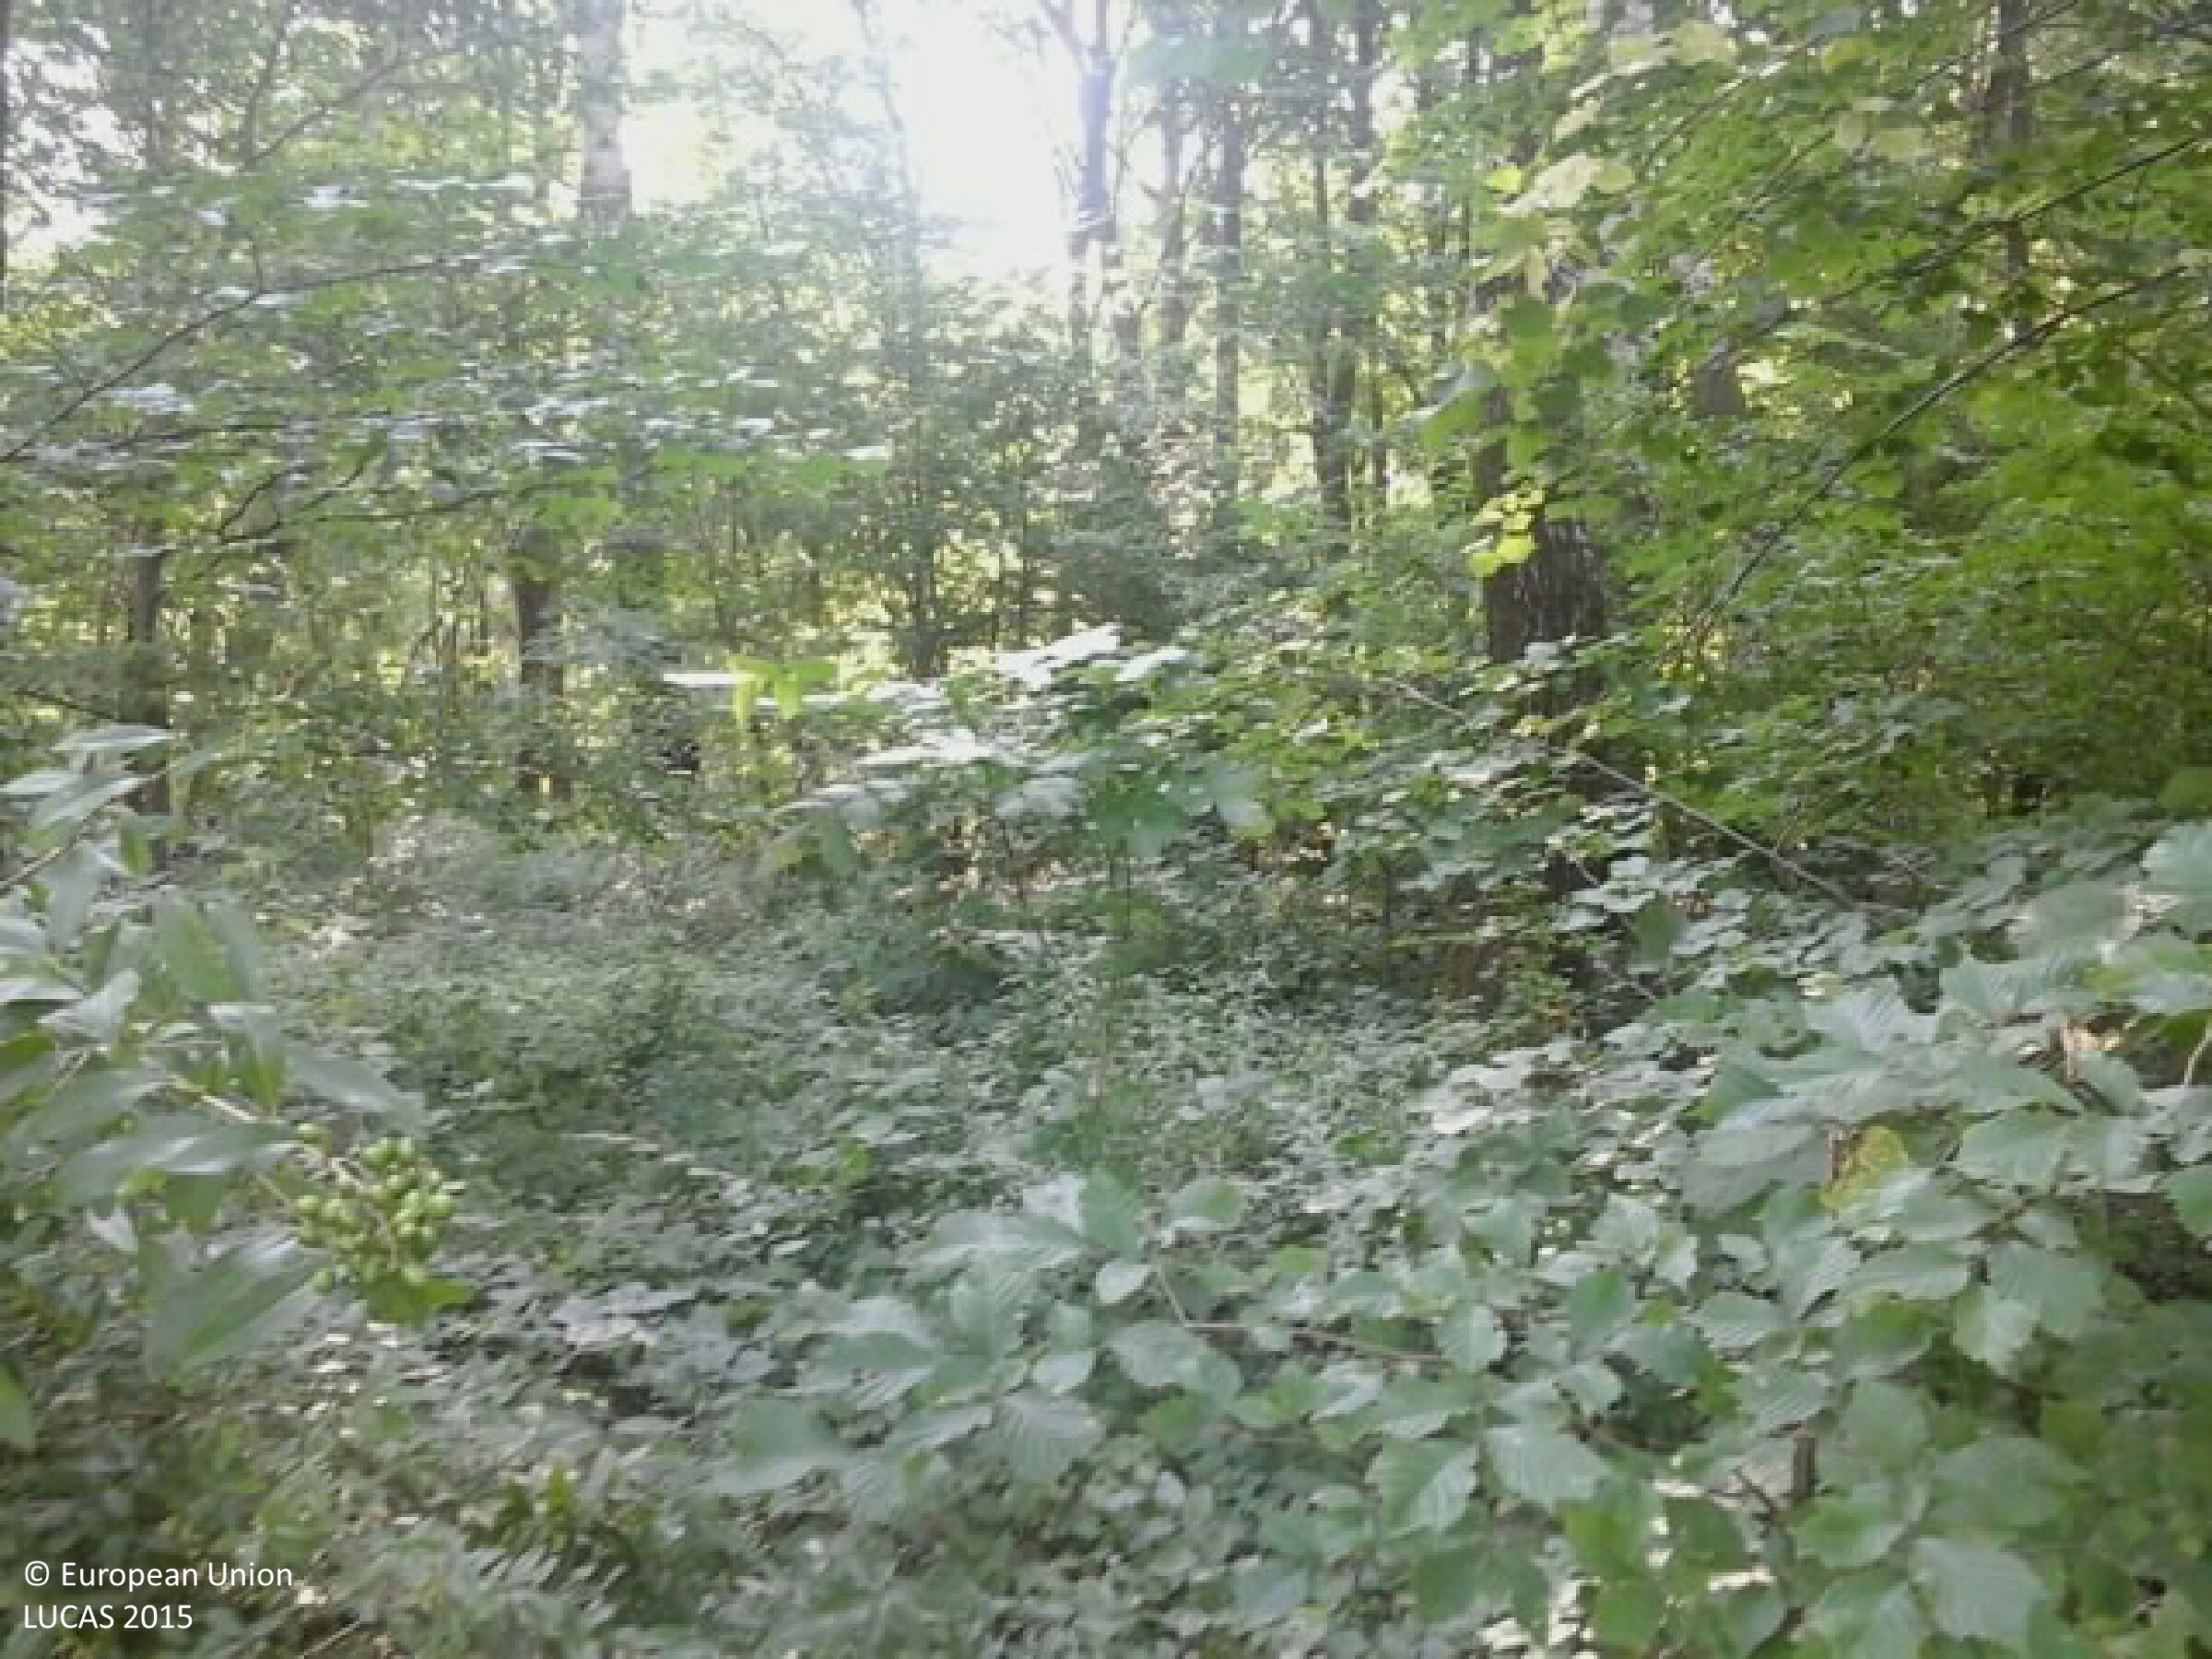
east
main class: Woodland
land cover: Broadleaved woodland
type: beech forest
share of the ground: > 75 %
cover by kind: broadleaved forest trees 95 %, herbaceous plants 5 %
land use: Forestry
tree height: < 5 m
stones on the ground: < 10 %
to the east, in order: Broadleaved woodland
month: August
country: HU
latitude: 46.4106
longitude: 18.0338
